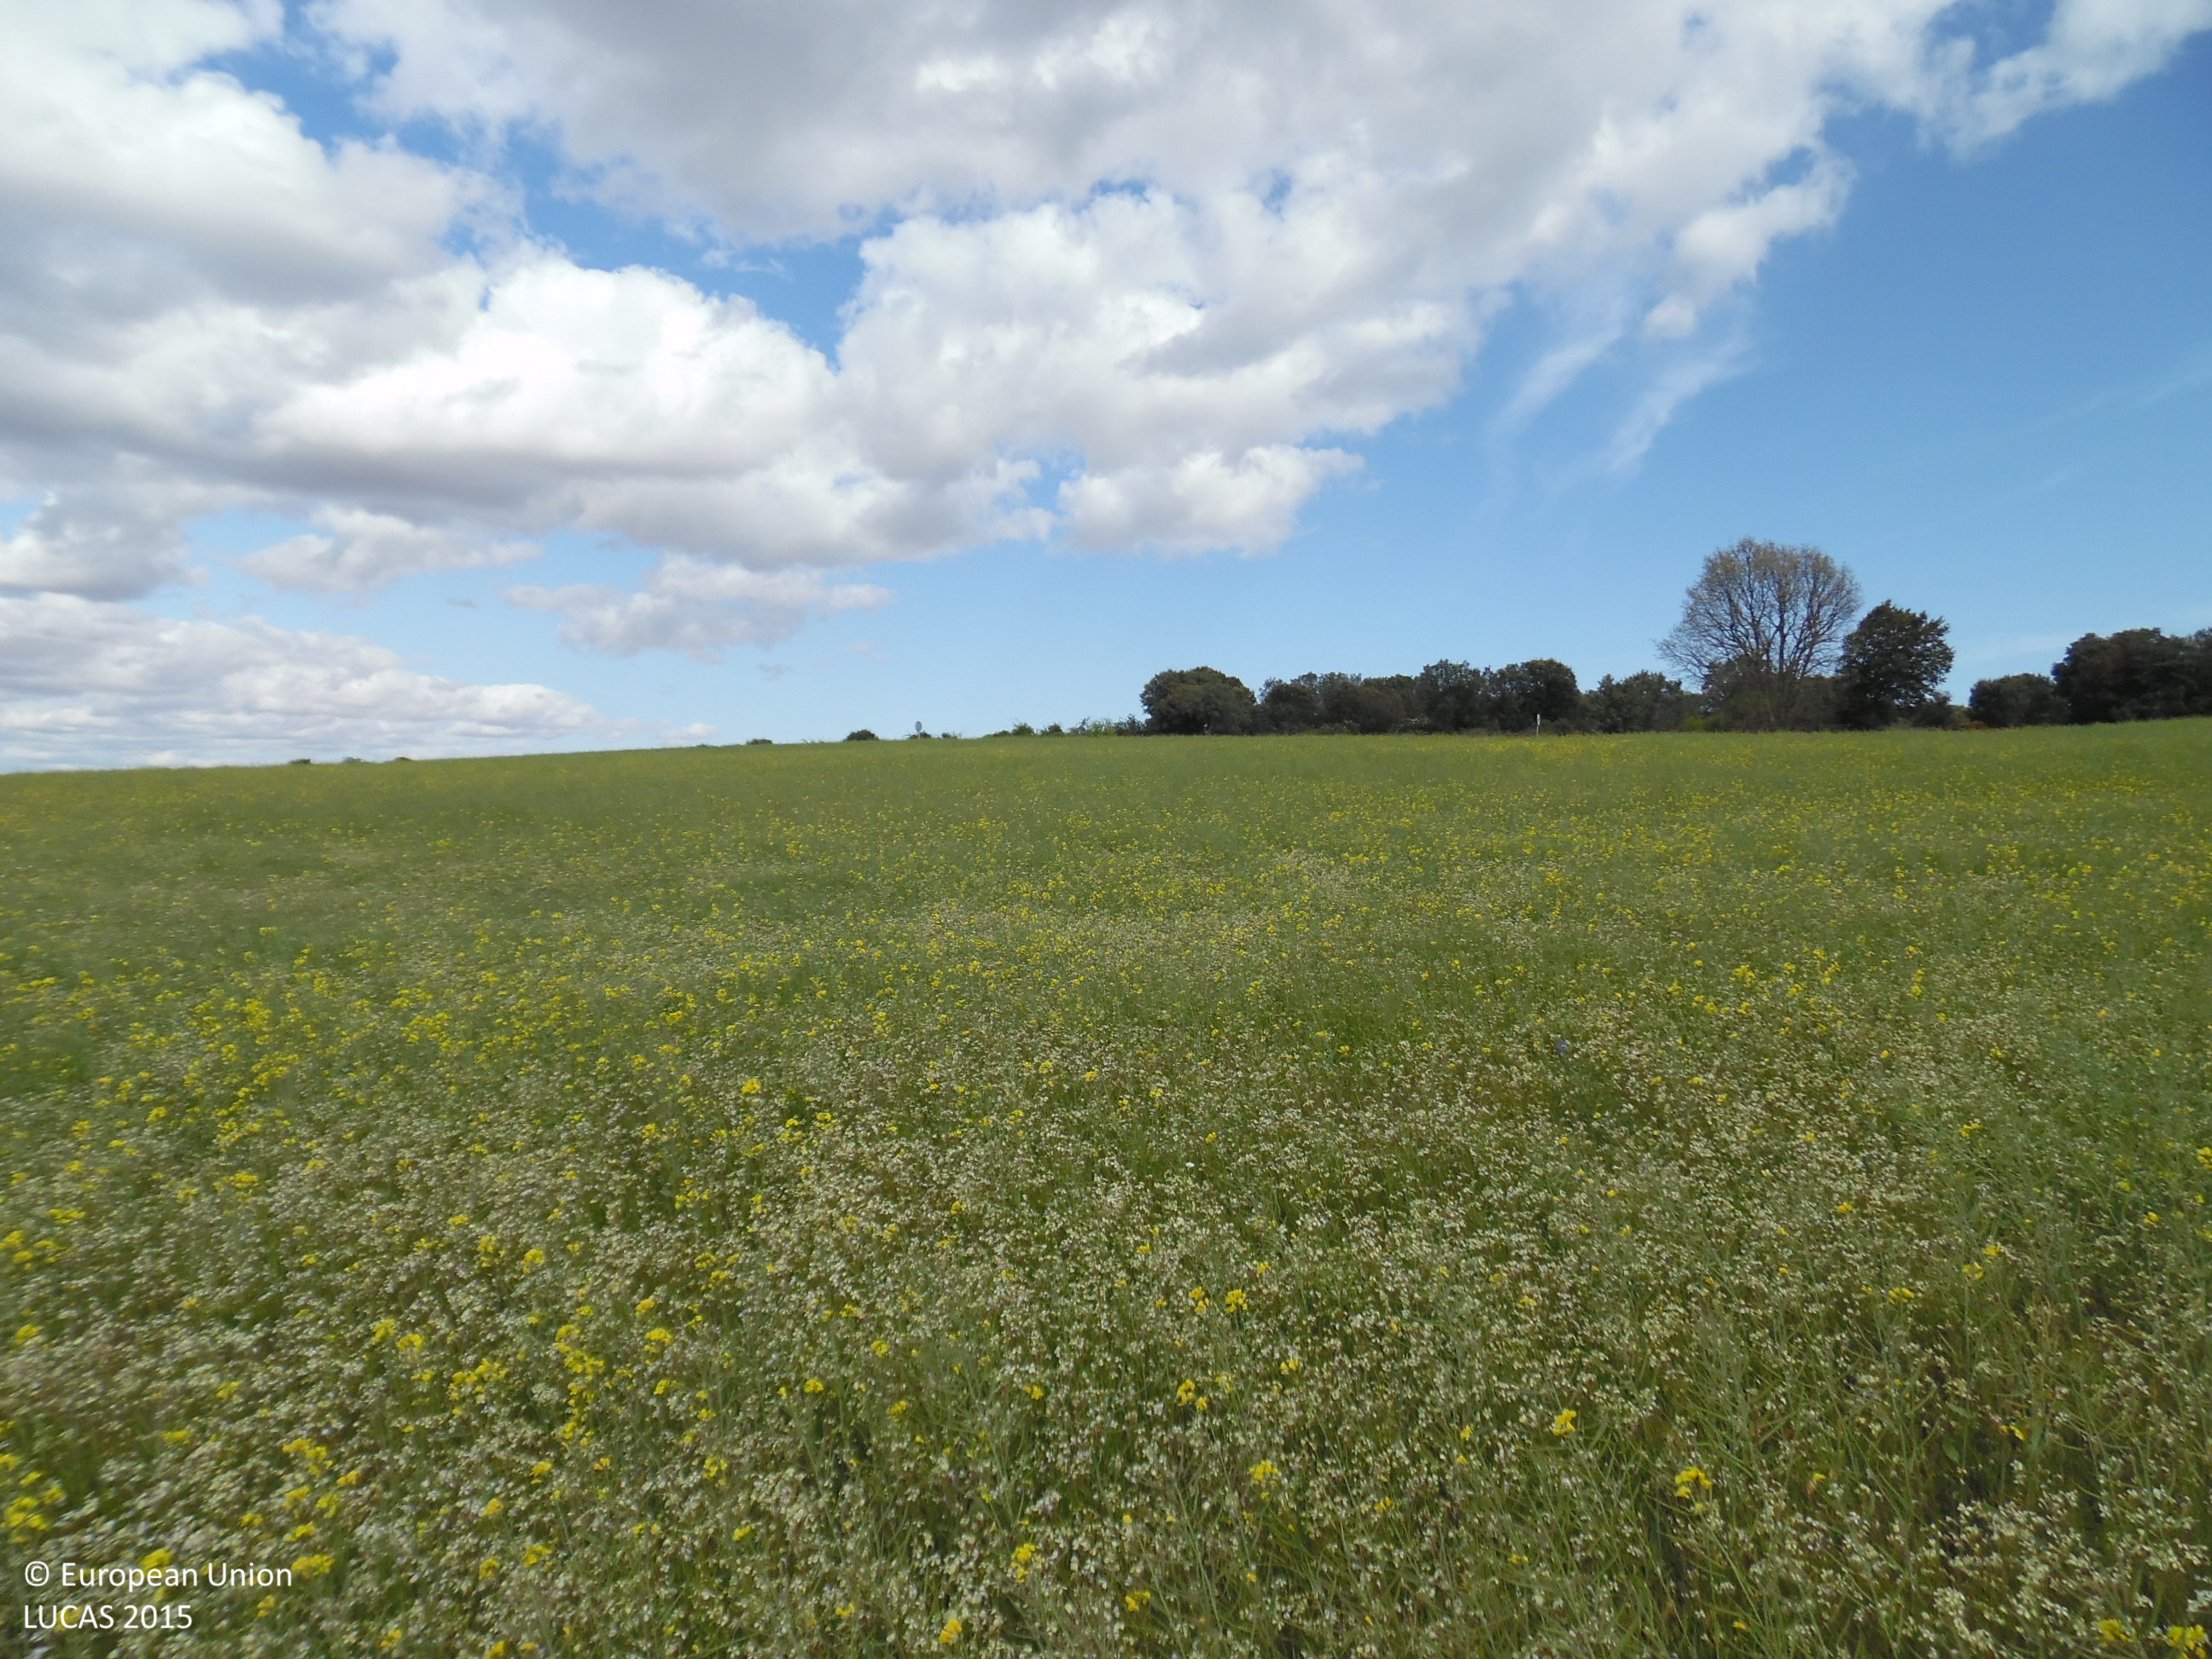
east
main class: Grassland
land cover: Spontaneously vegetated surfaces
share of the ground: > 75 %
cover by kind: herbaceous plants 100 %
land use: Fallow land
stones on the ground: 10 - 25 %
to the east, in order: Spontaneously vegetated surfaces; Grass margins; Paved roads, cycling and walking lanes; Grass margins; Vineyards; Shrubland with sparse tree cover; Grassland with sparse tree/shrub cover; Vineyards; Grassland with sparse tree/shrub cover; Vineyards
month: May
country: ES
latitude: 42.2556
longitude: -5.9930
